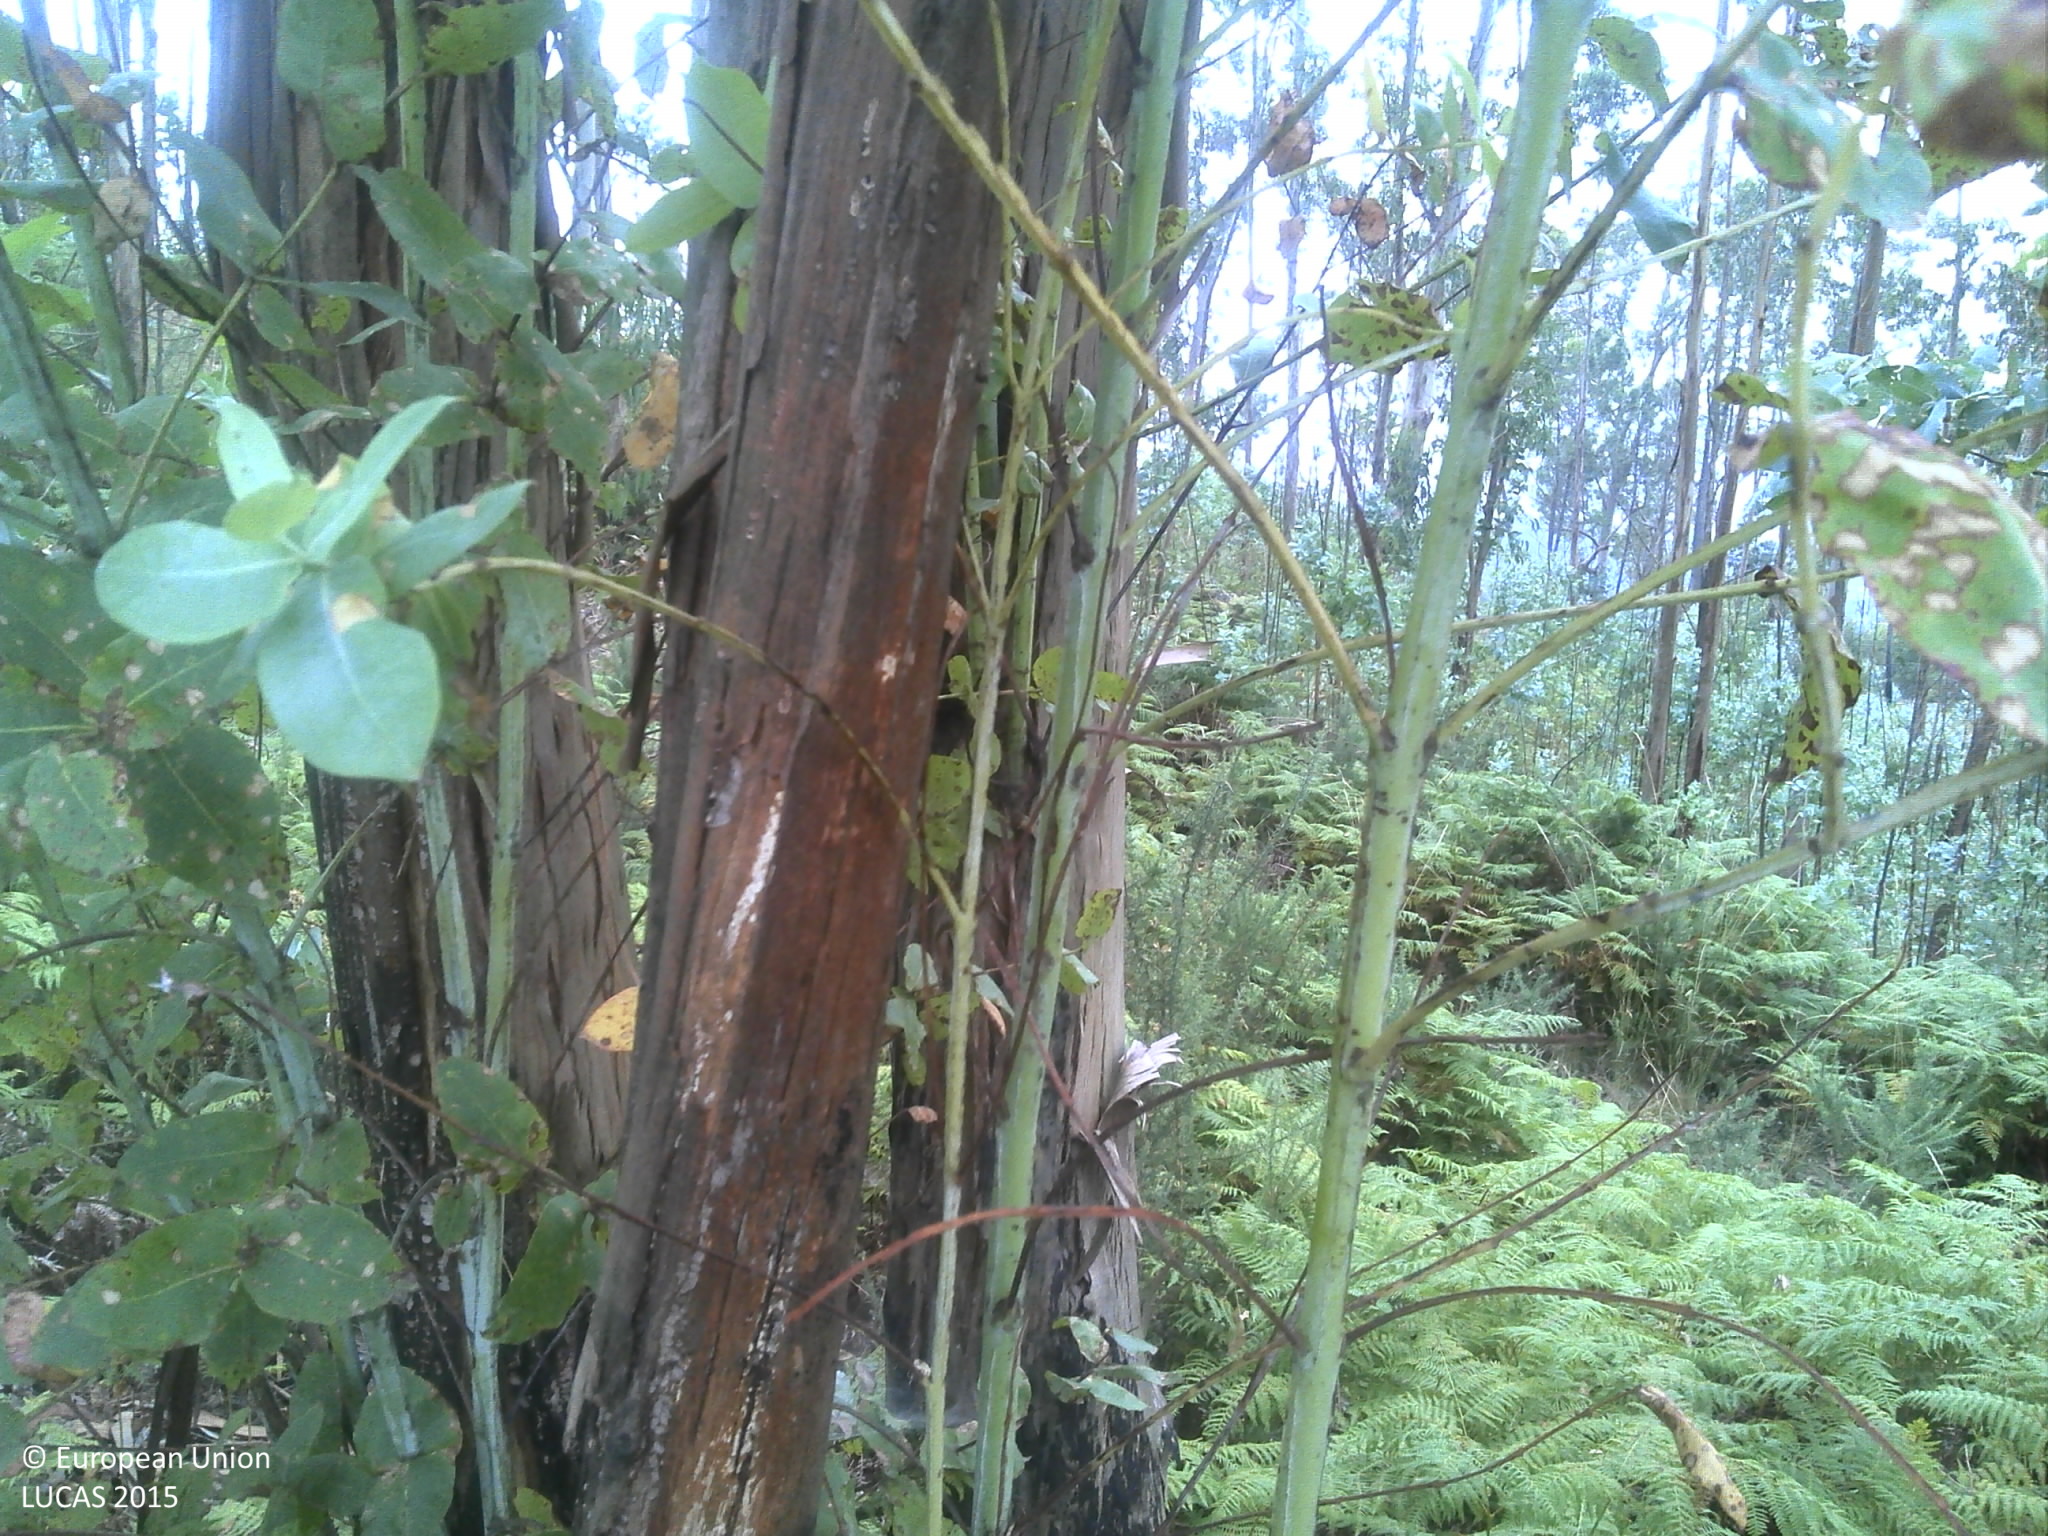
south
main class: Woodland
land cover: Broadleaved woodland
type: exotic forest
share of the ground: 50 - 75 %
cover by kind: broadleaved forest trees 70 %, shrubs 25 %, unconsolidated bare surface 5 %
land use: Forestry
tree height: > 5 m
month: June
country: PT
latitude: 41.2912
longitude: -8.1612
